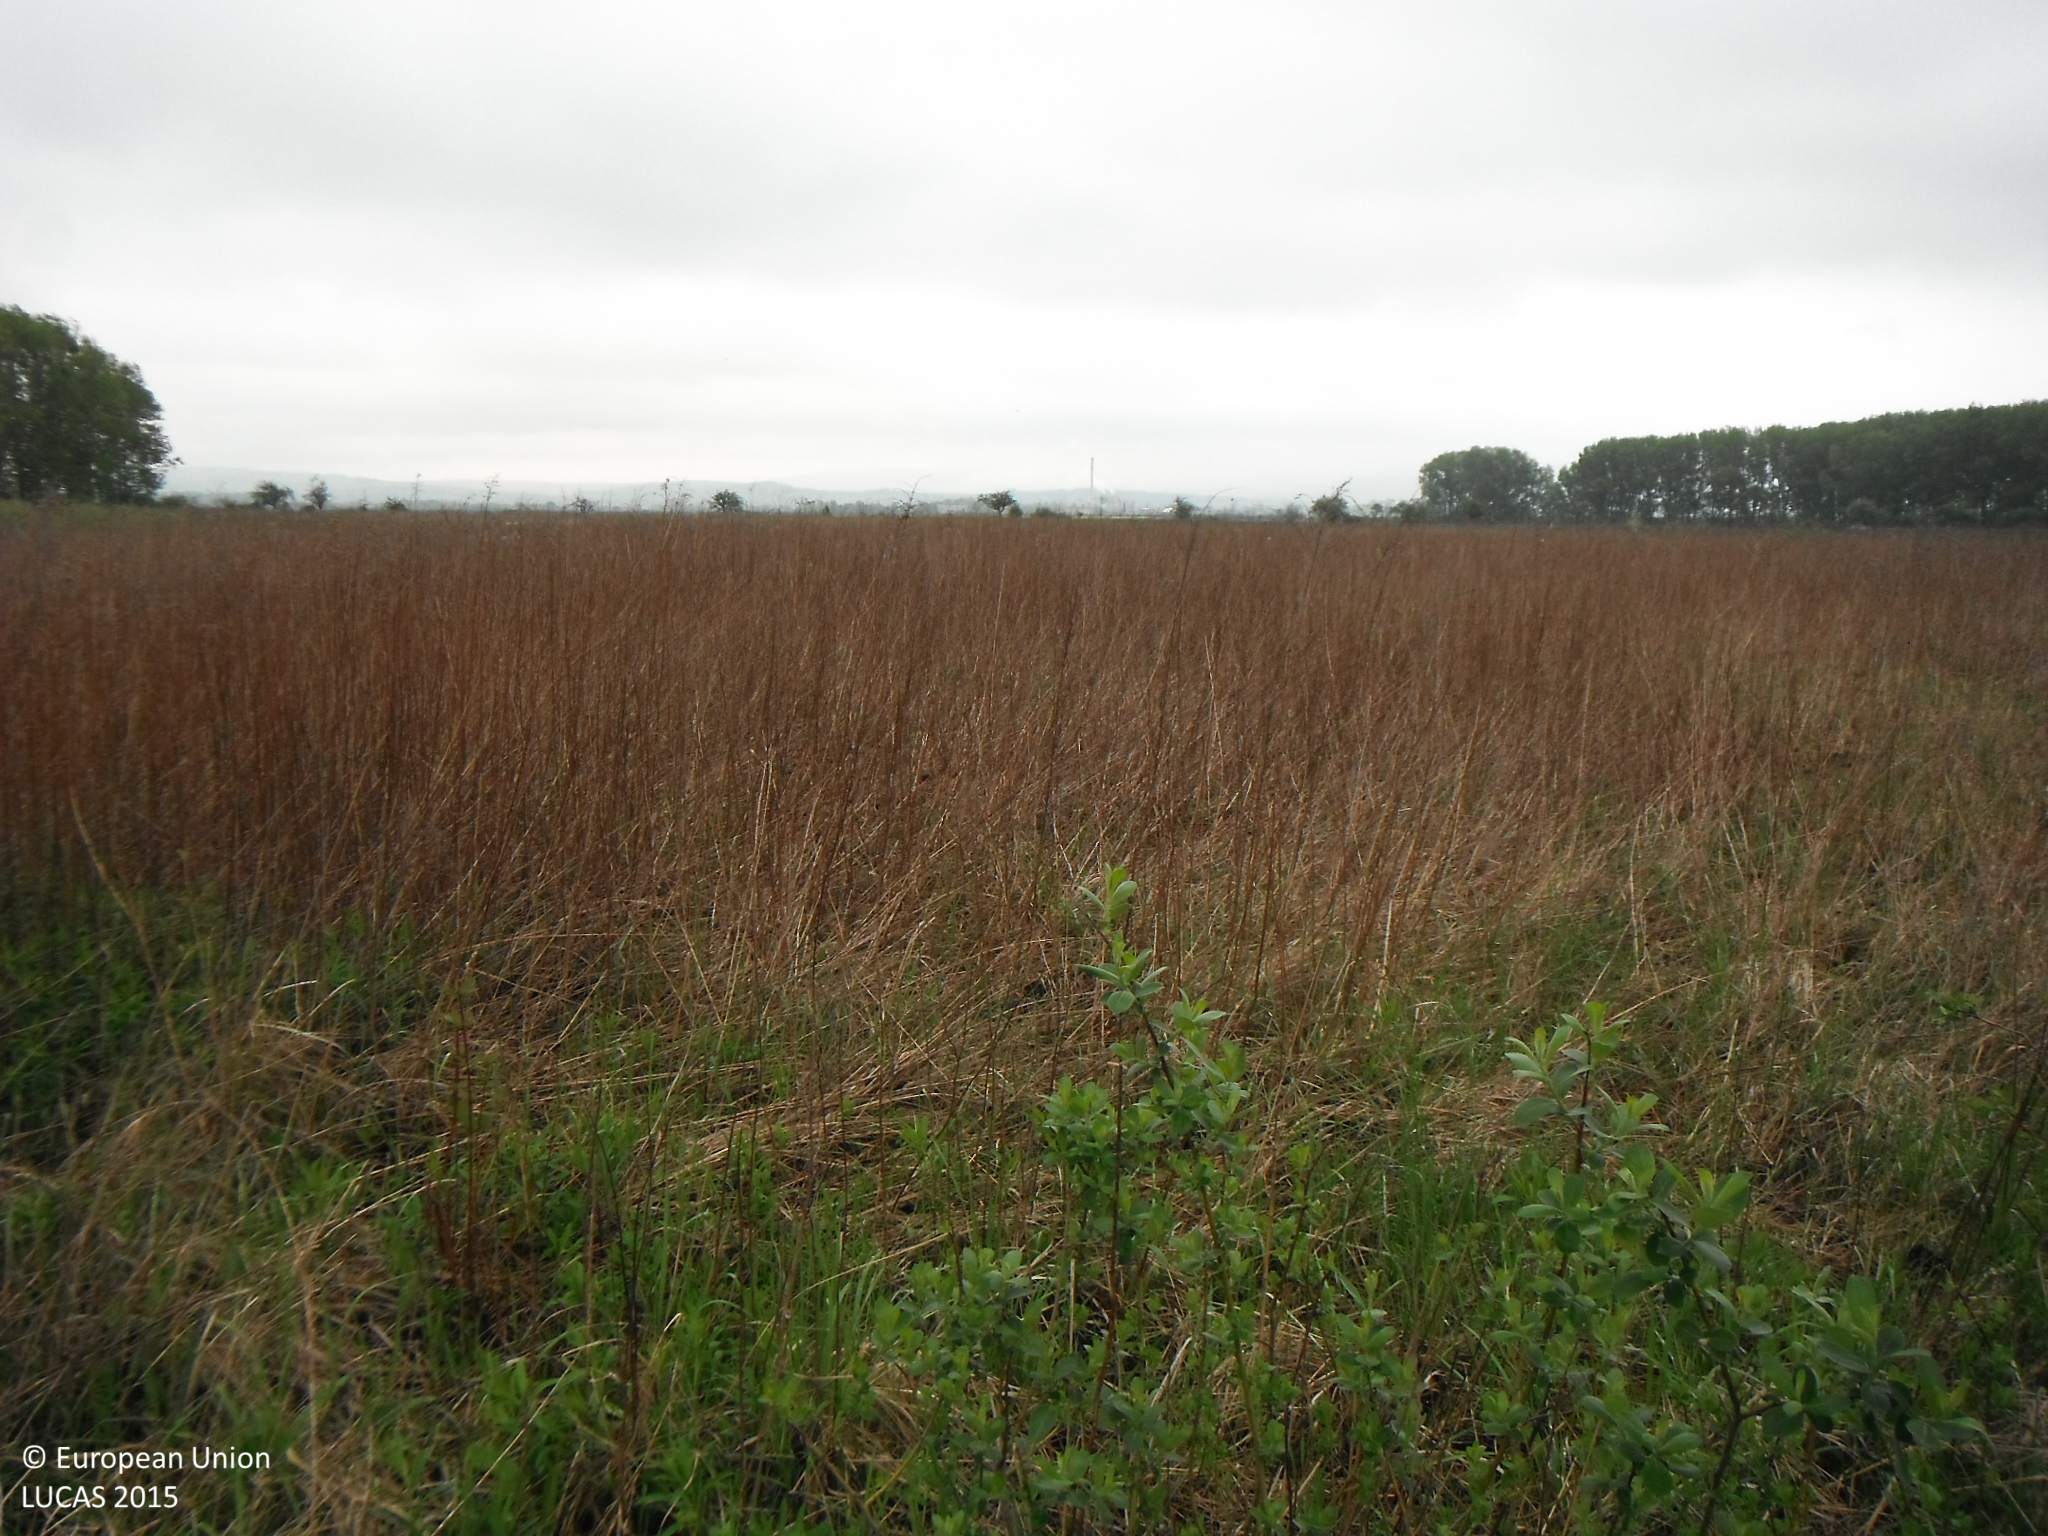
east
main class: Shrubland
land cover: Shrubland without tree cover
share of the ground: > 75 %
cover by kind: herbaceous plants 75 %, shrubs 25 %
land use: Abandoned areas
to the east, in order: Shrubland without tree cover; Spontaneously vegetated surfaces
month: May
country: SK
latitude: 48.6606
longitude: 21.2725
